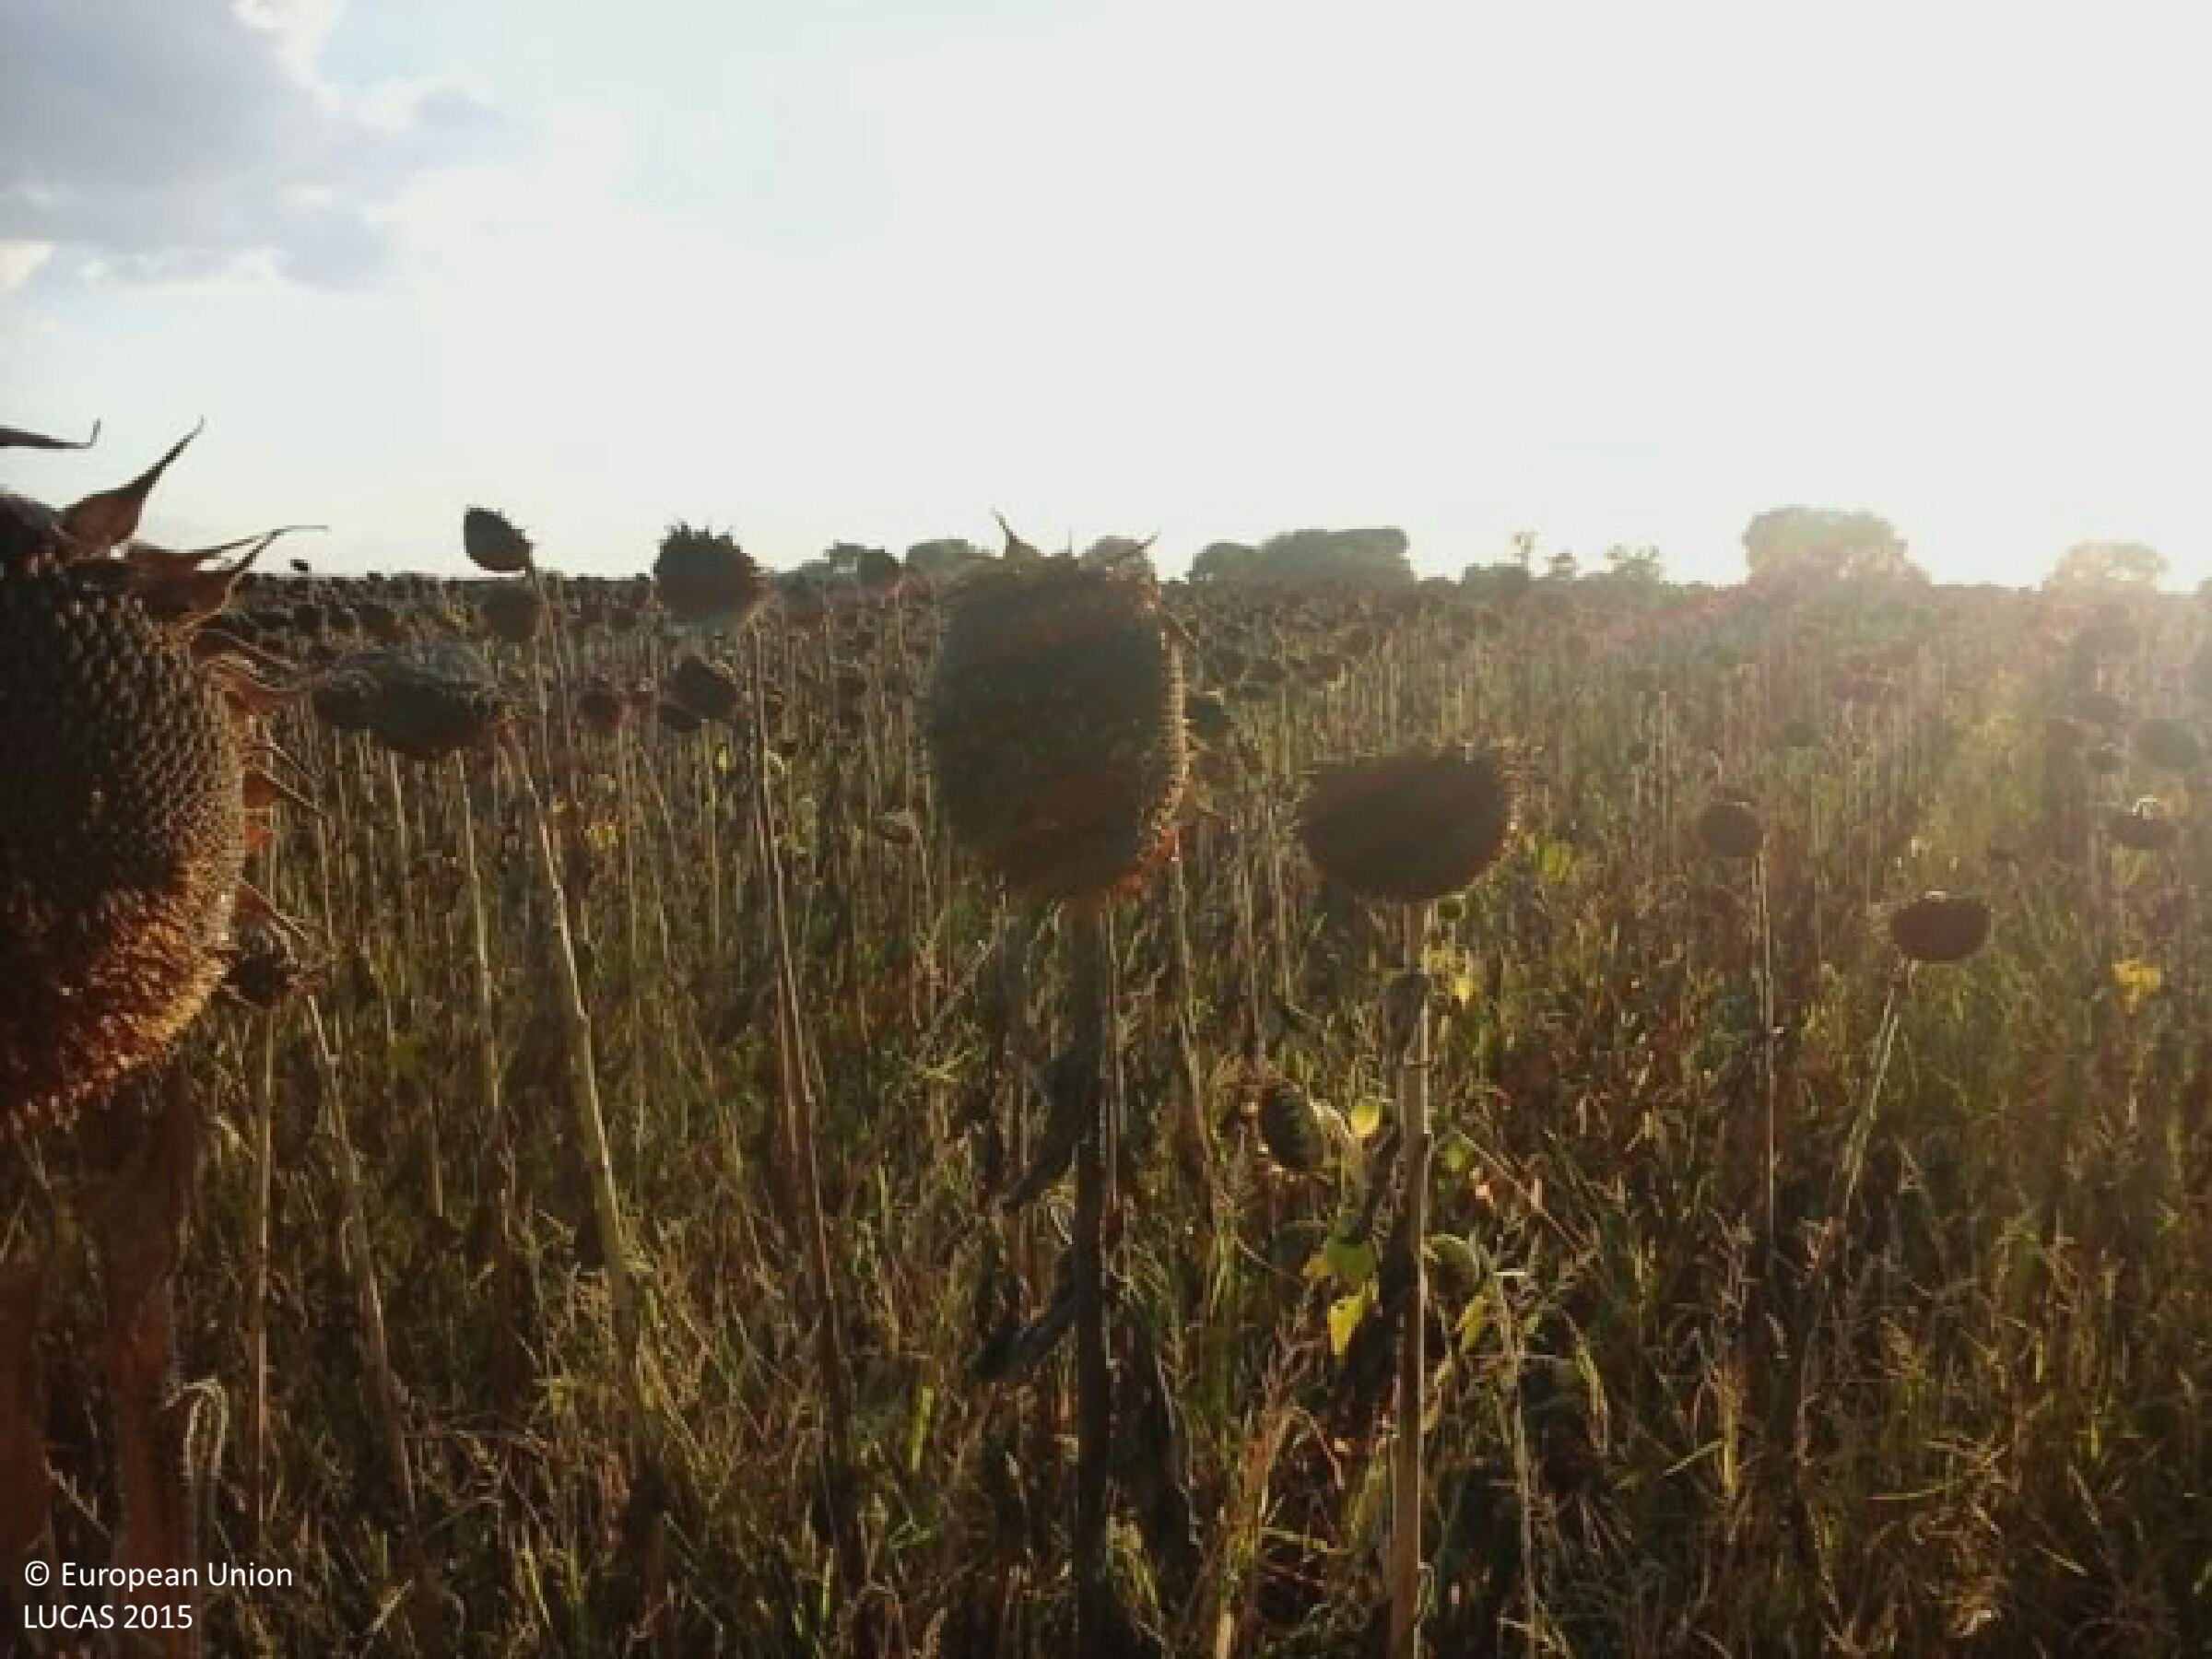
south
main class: Cropland
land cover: Sunflower
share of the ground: > 75 %
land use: Agriculture (excluding fallow land and kitchen gardens)
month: September
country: HU
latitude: 47.7197
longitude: 19.9309
